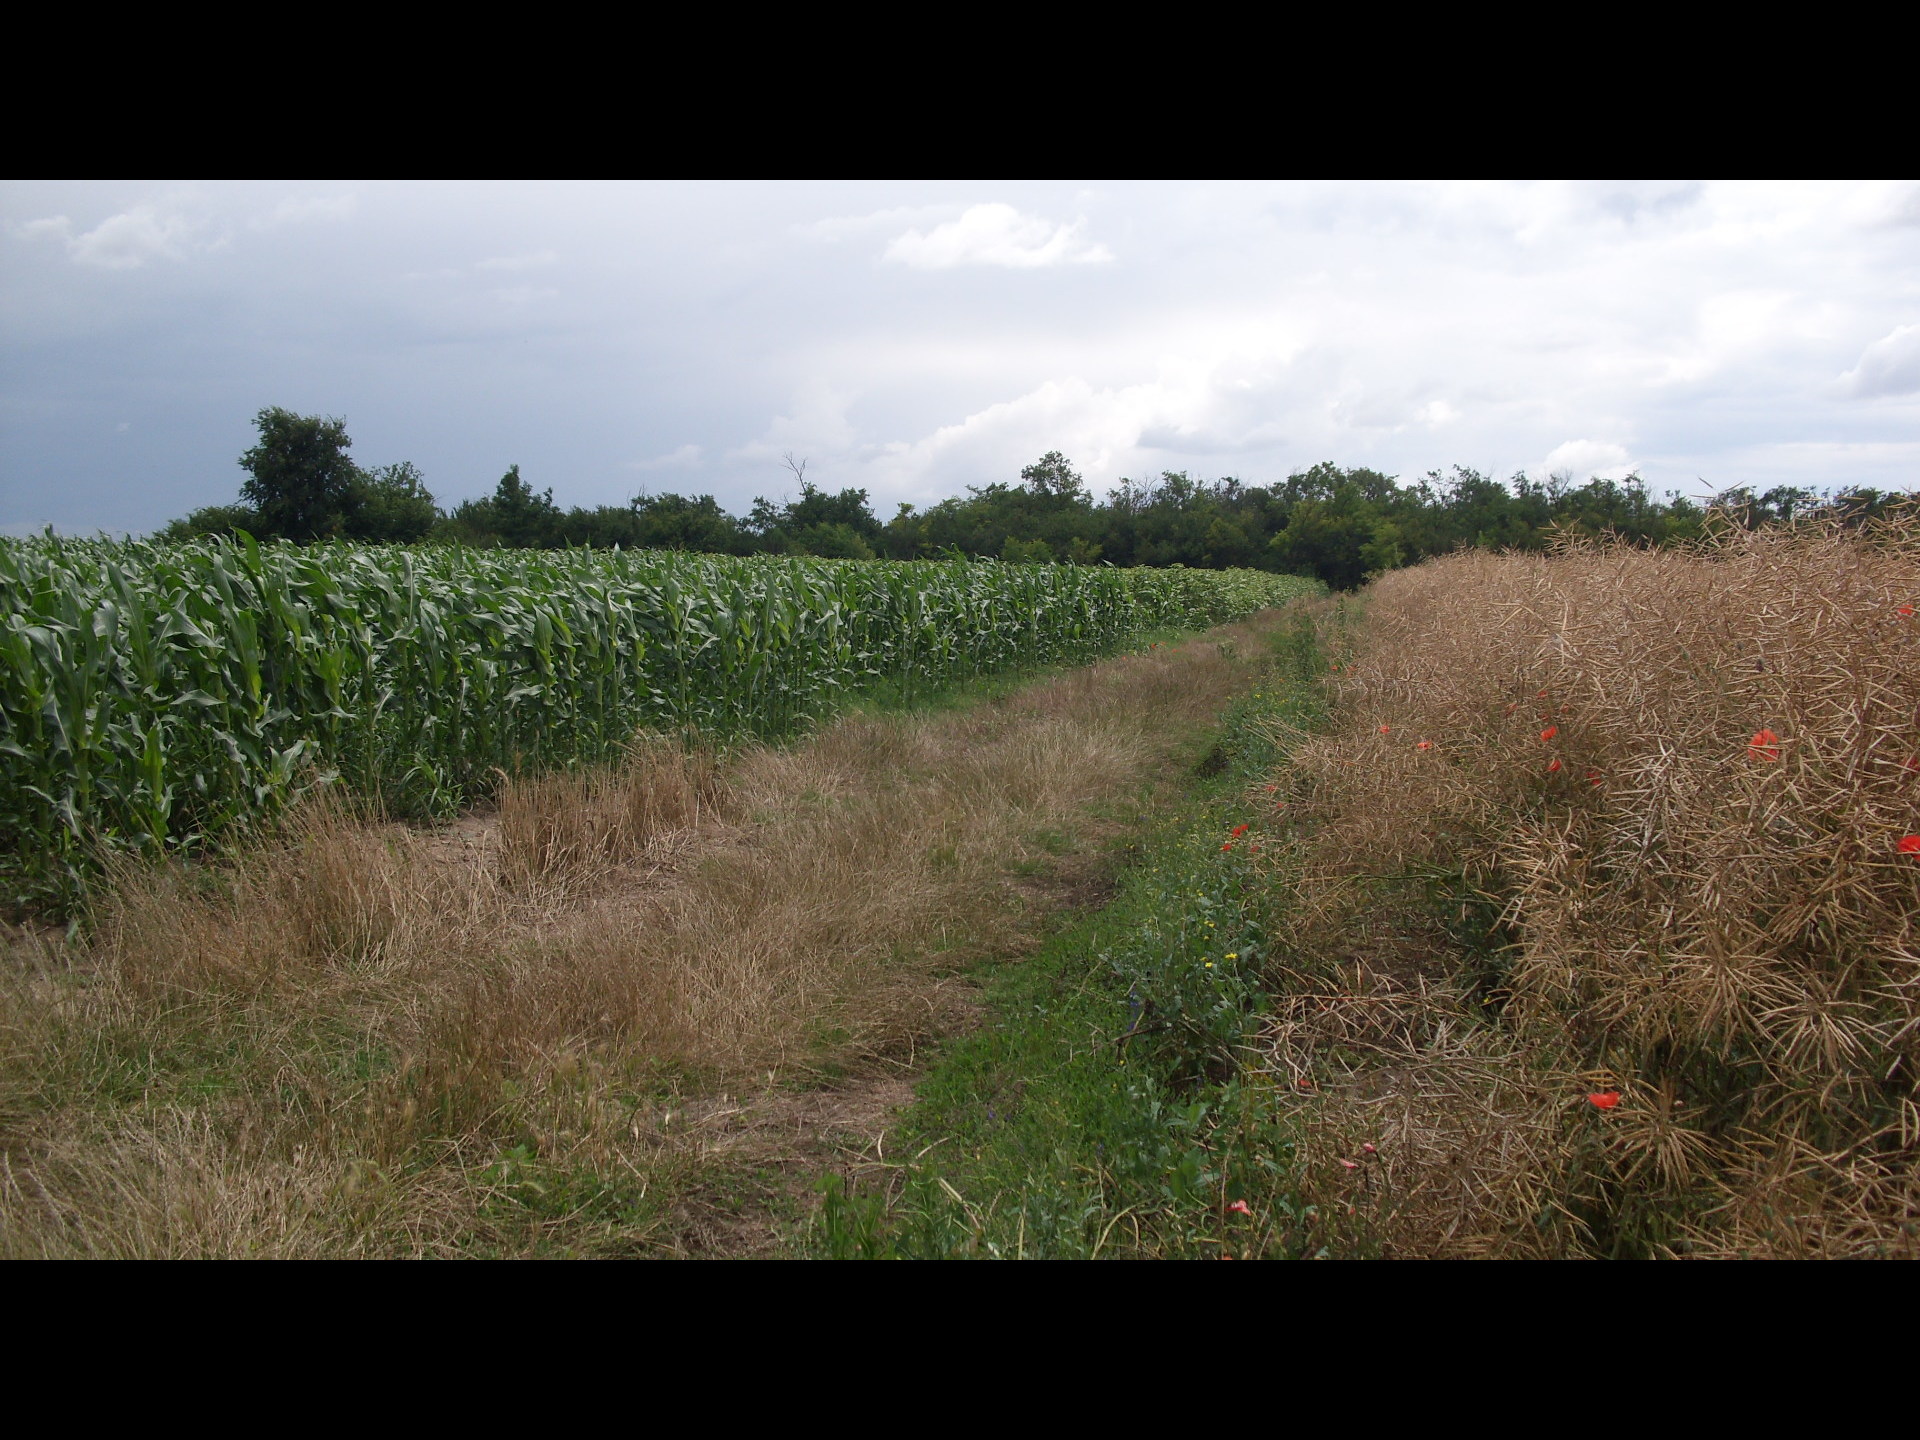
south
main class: Cropland
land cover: Rape and turnip rape
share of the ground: > 75 %
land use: Agriculture (excluding fallow land and kitchen gardens)
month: June
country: BG
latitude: 43.6371
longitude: 23.5705
